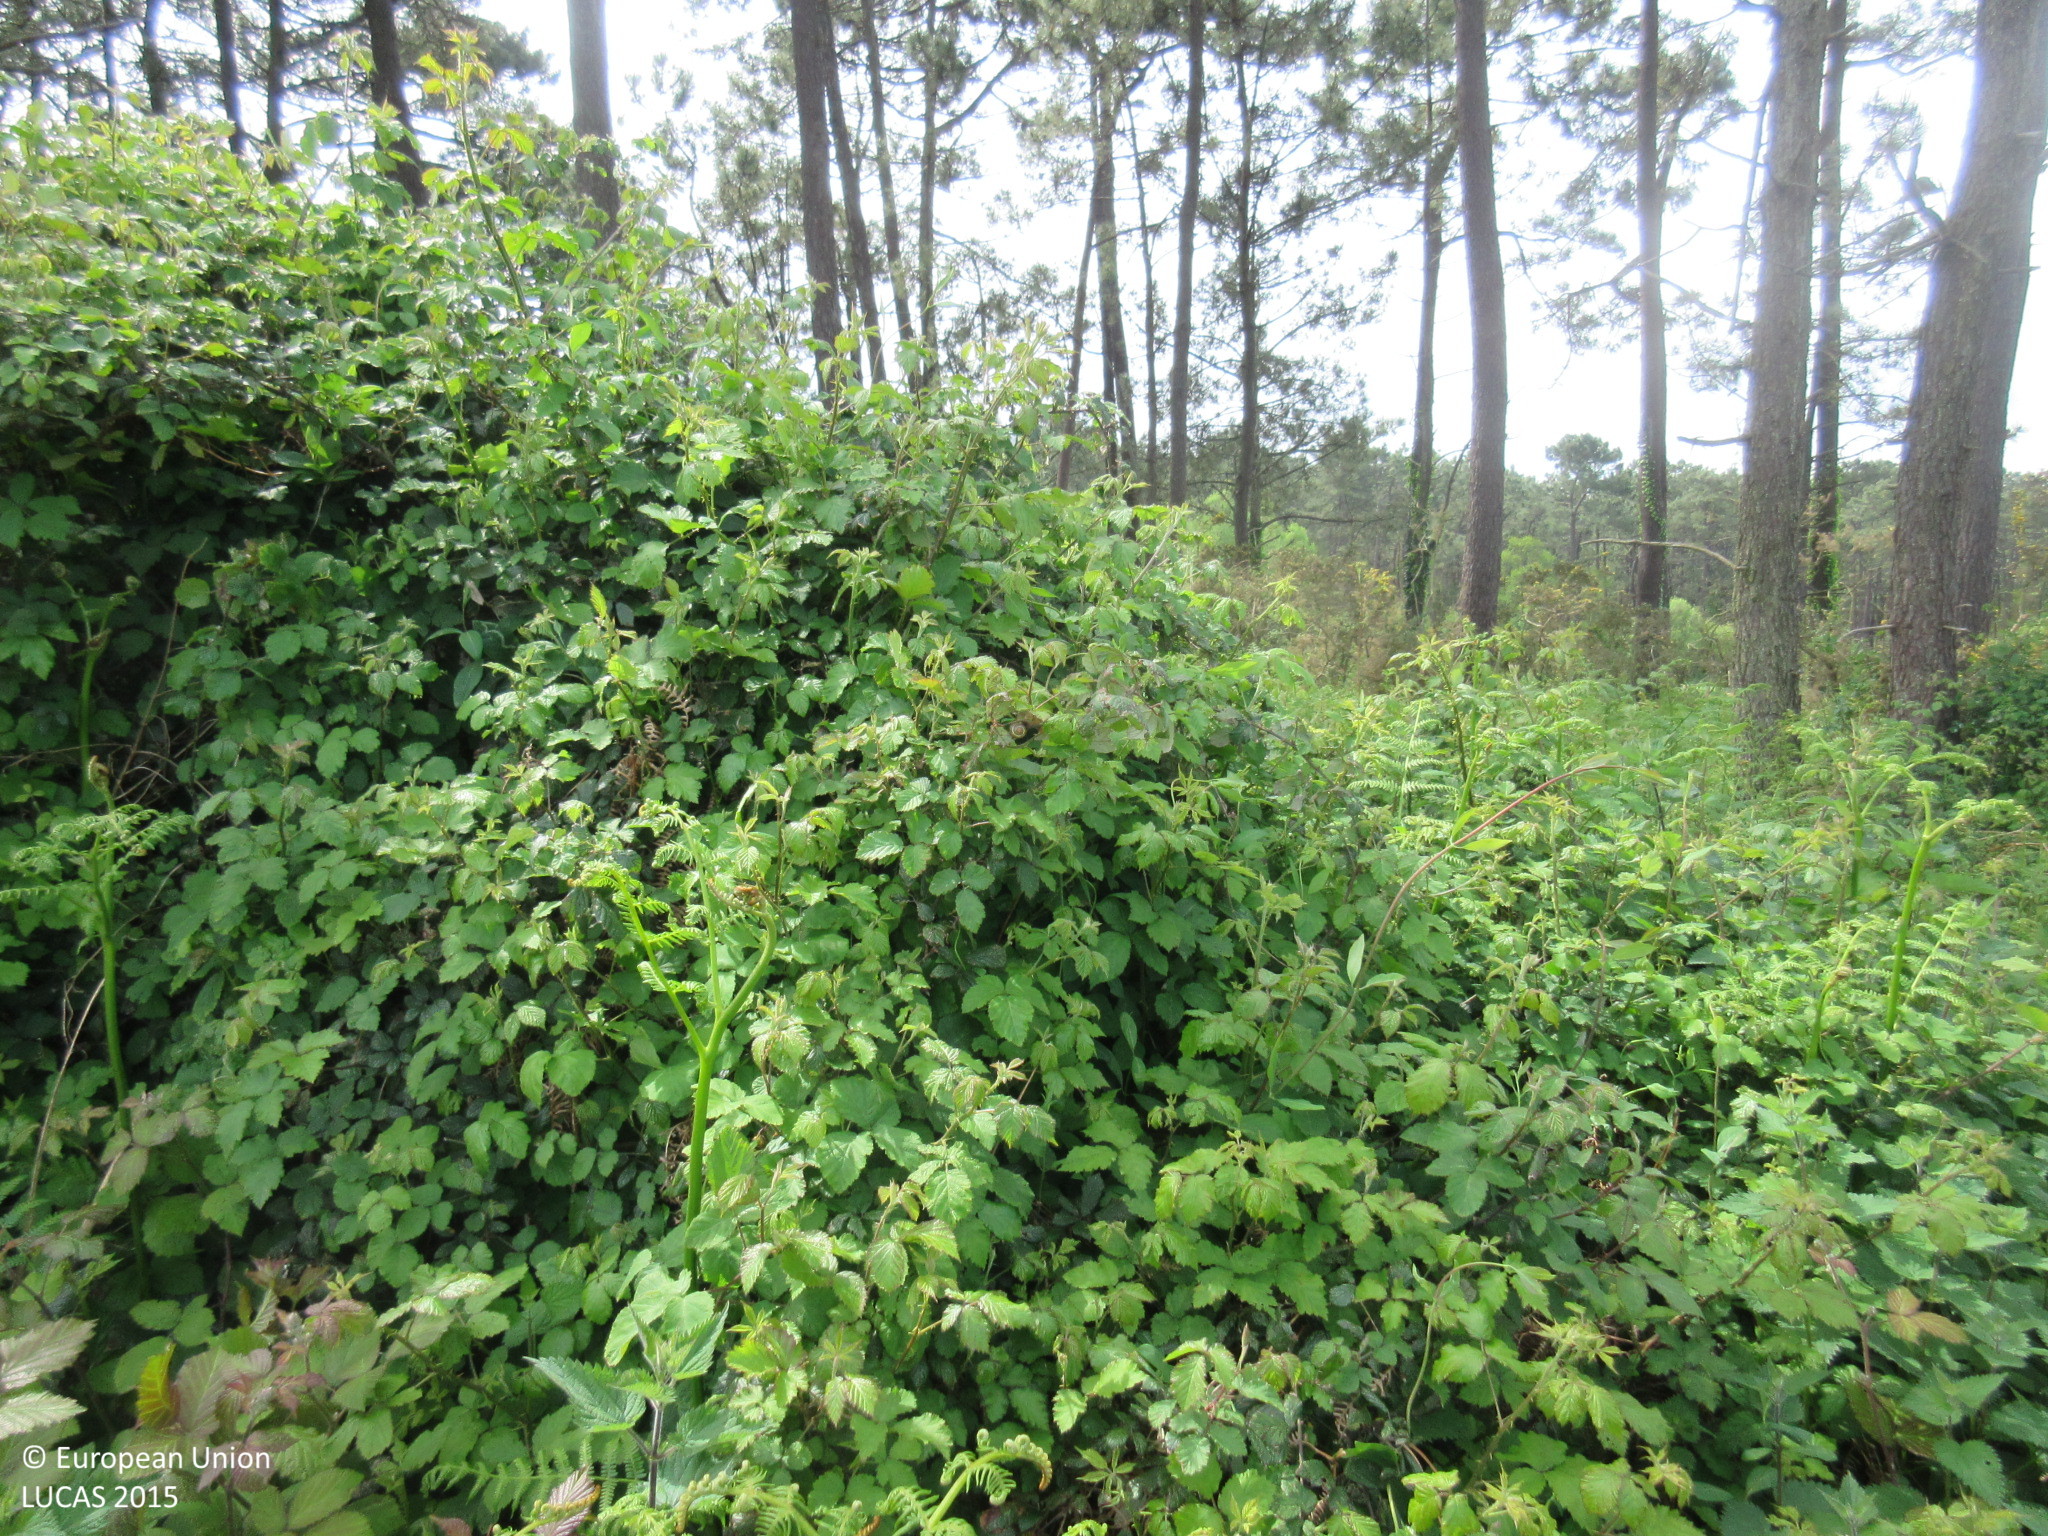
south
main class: Woodland
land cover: Pine dominated coniferous woodland
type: exotic forest
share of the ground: > 75 %
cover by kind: coniferous forest trees 100 %
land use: Forestry
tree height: > 5 m
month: April
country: ES
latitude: 43.5484
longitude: -6.6323
